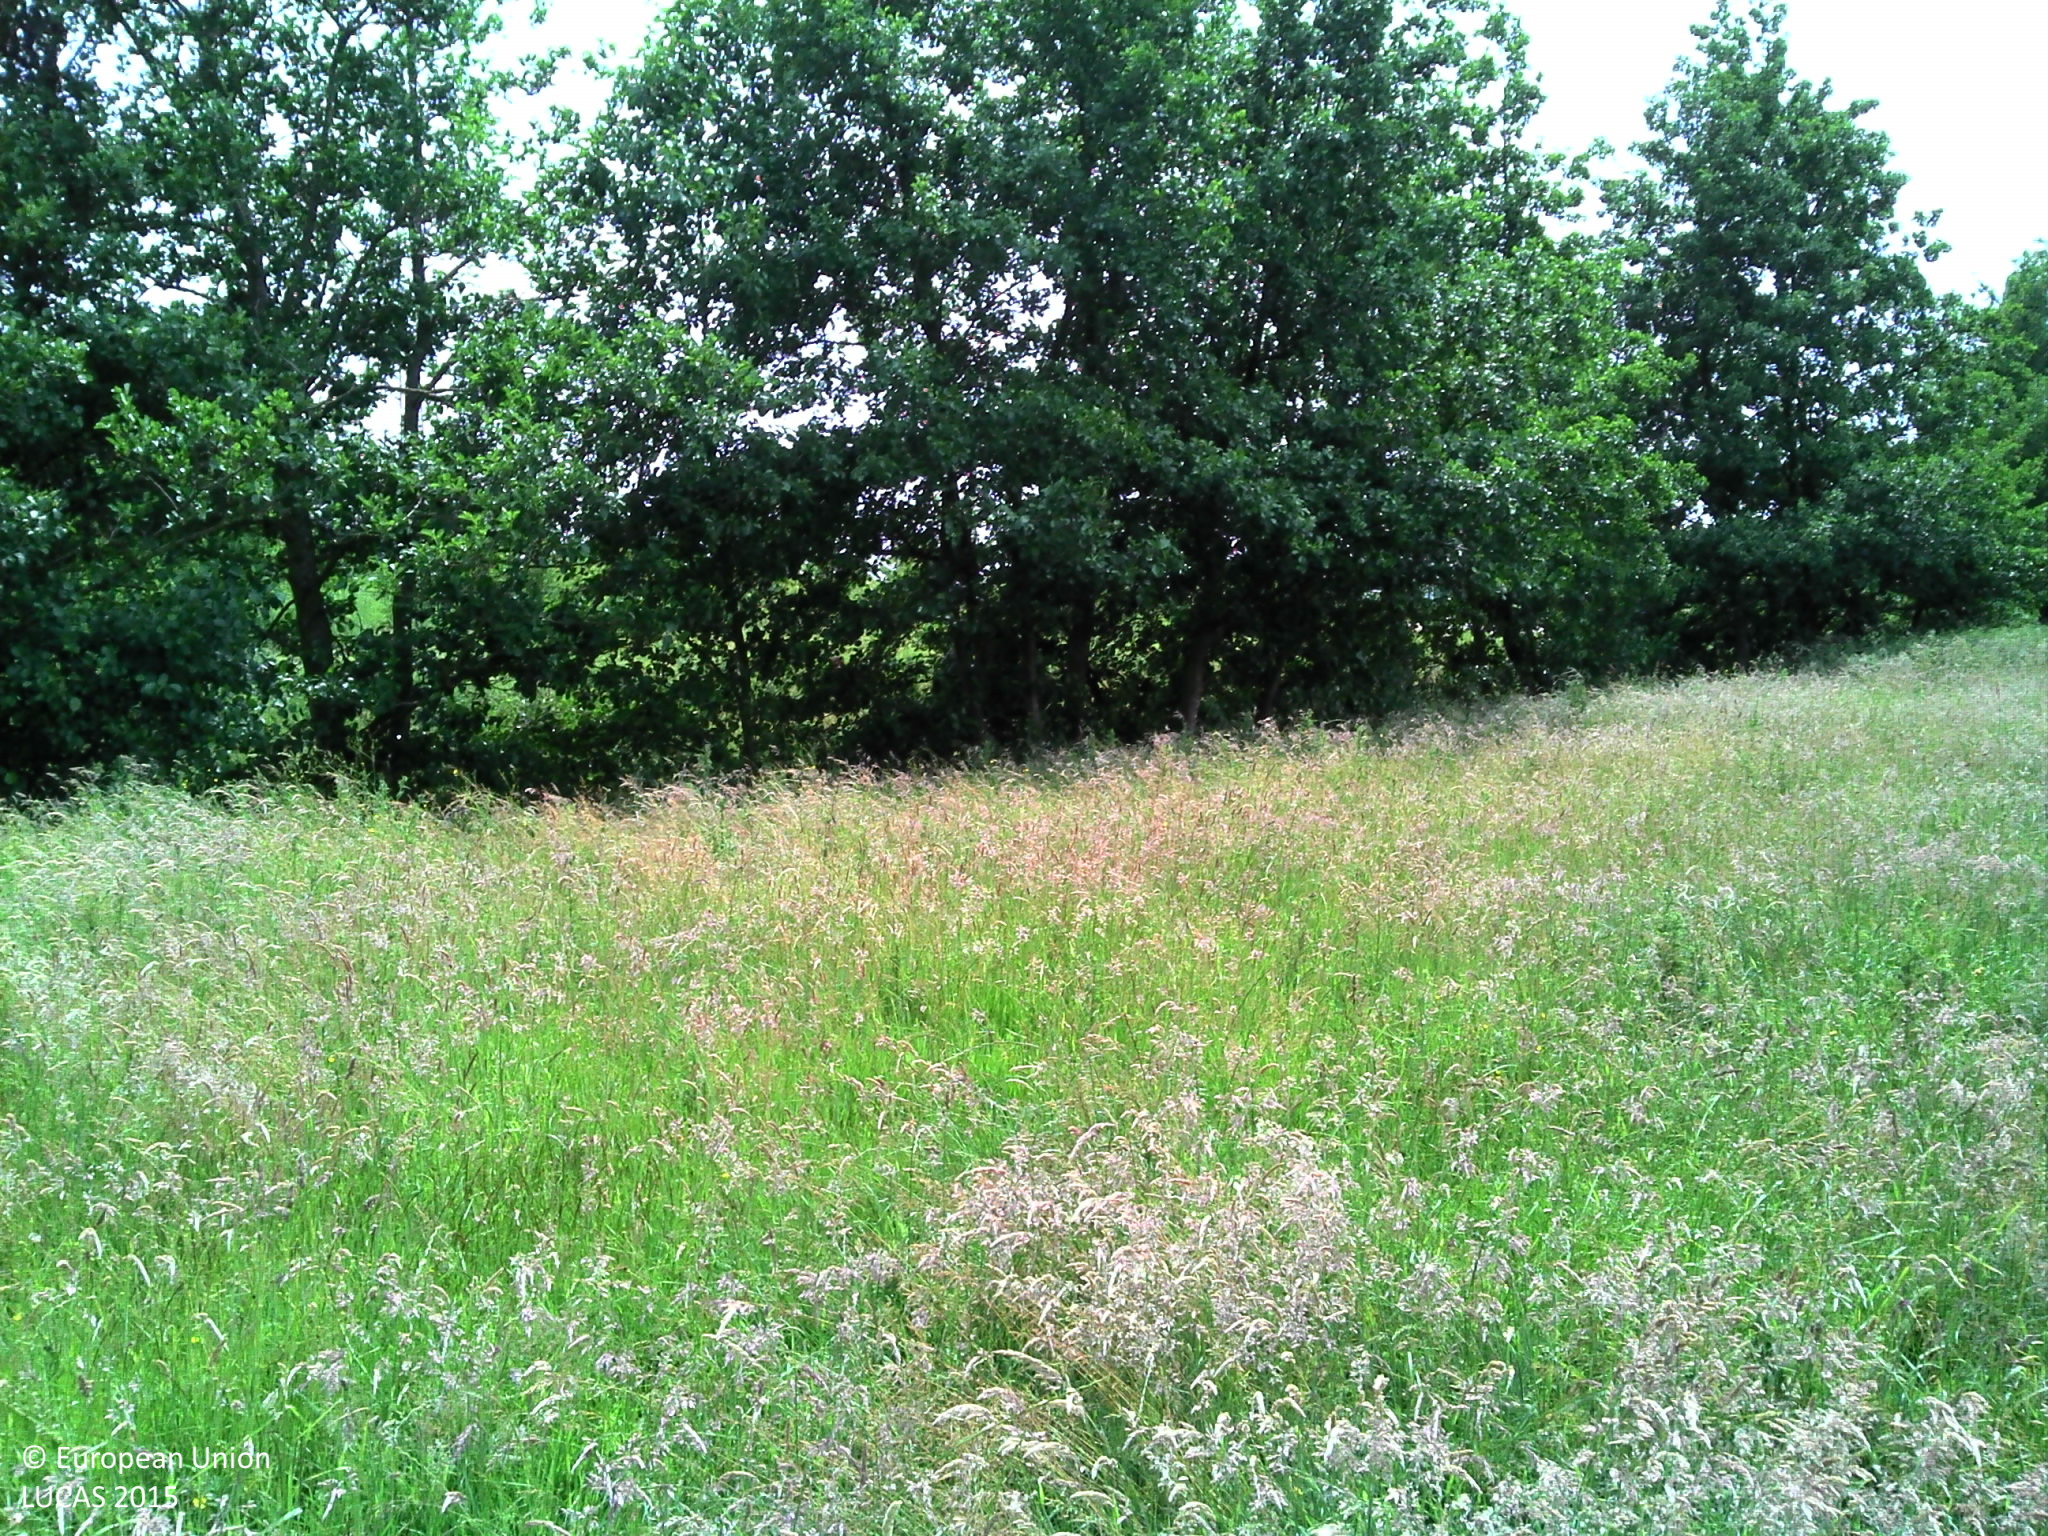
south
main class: Grassland
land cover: Grassland without tree/shrub cover
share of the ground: > 75 %
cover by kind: herbaceous plants 100 %
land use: Agriculture (excluding fallow land and kitchen gardens)
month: June
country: BE
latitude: 50.6459
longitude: 3.7850
